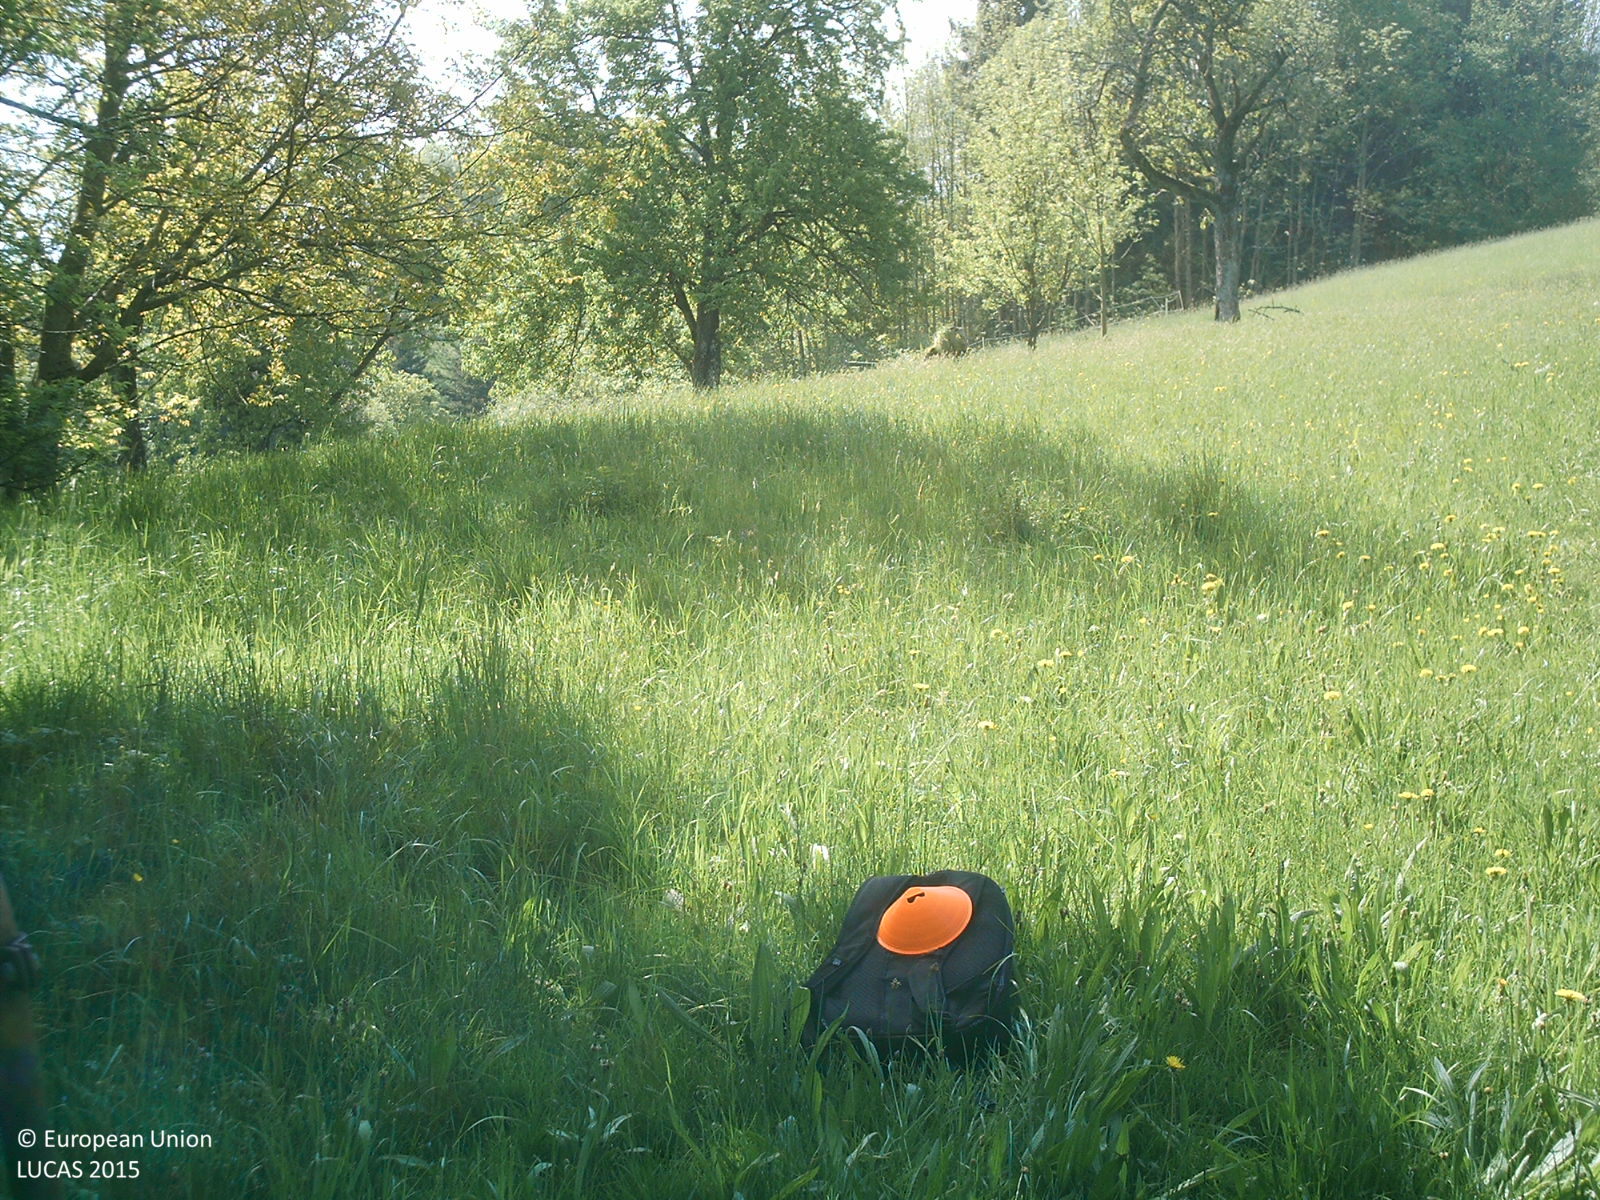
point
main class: Woodland
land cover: Broadleaved woodland
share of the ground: 50 - 75 %
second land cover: Grassland without tree/shrub cover
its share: > 75 %
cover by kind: broadleaved forest trees 50 %, shrubs 50 %
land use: Residential
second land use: Agriculture (excluding fallow land and kitchen gardens)
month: May
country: AT
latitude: 47.9138
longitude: 14.0804
